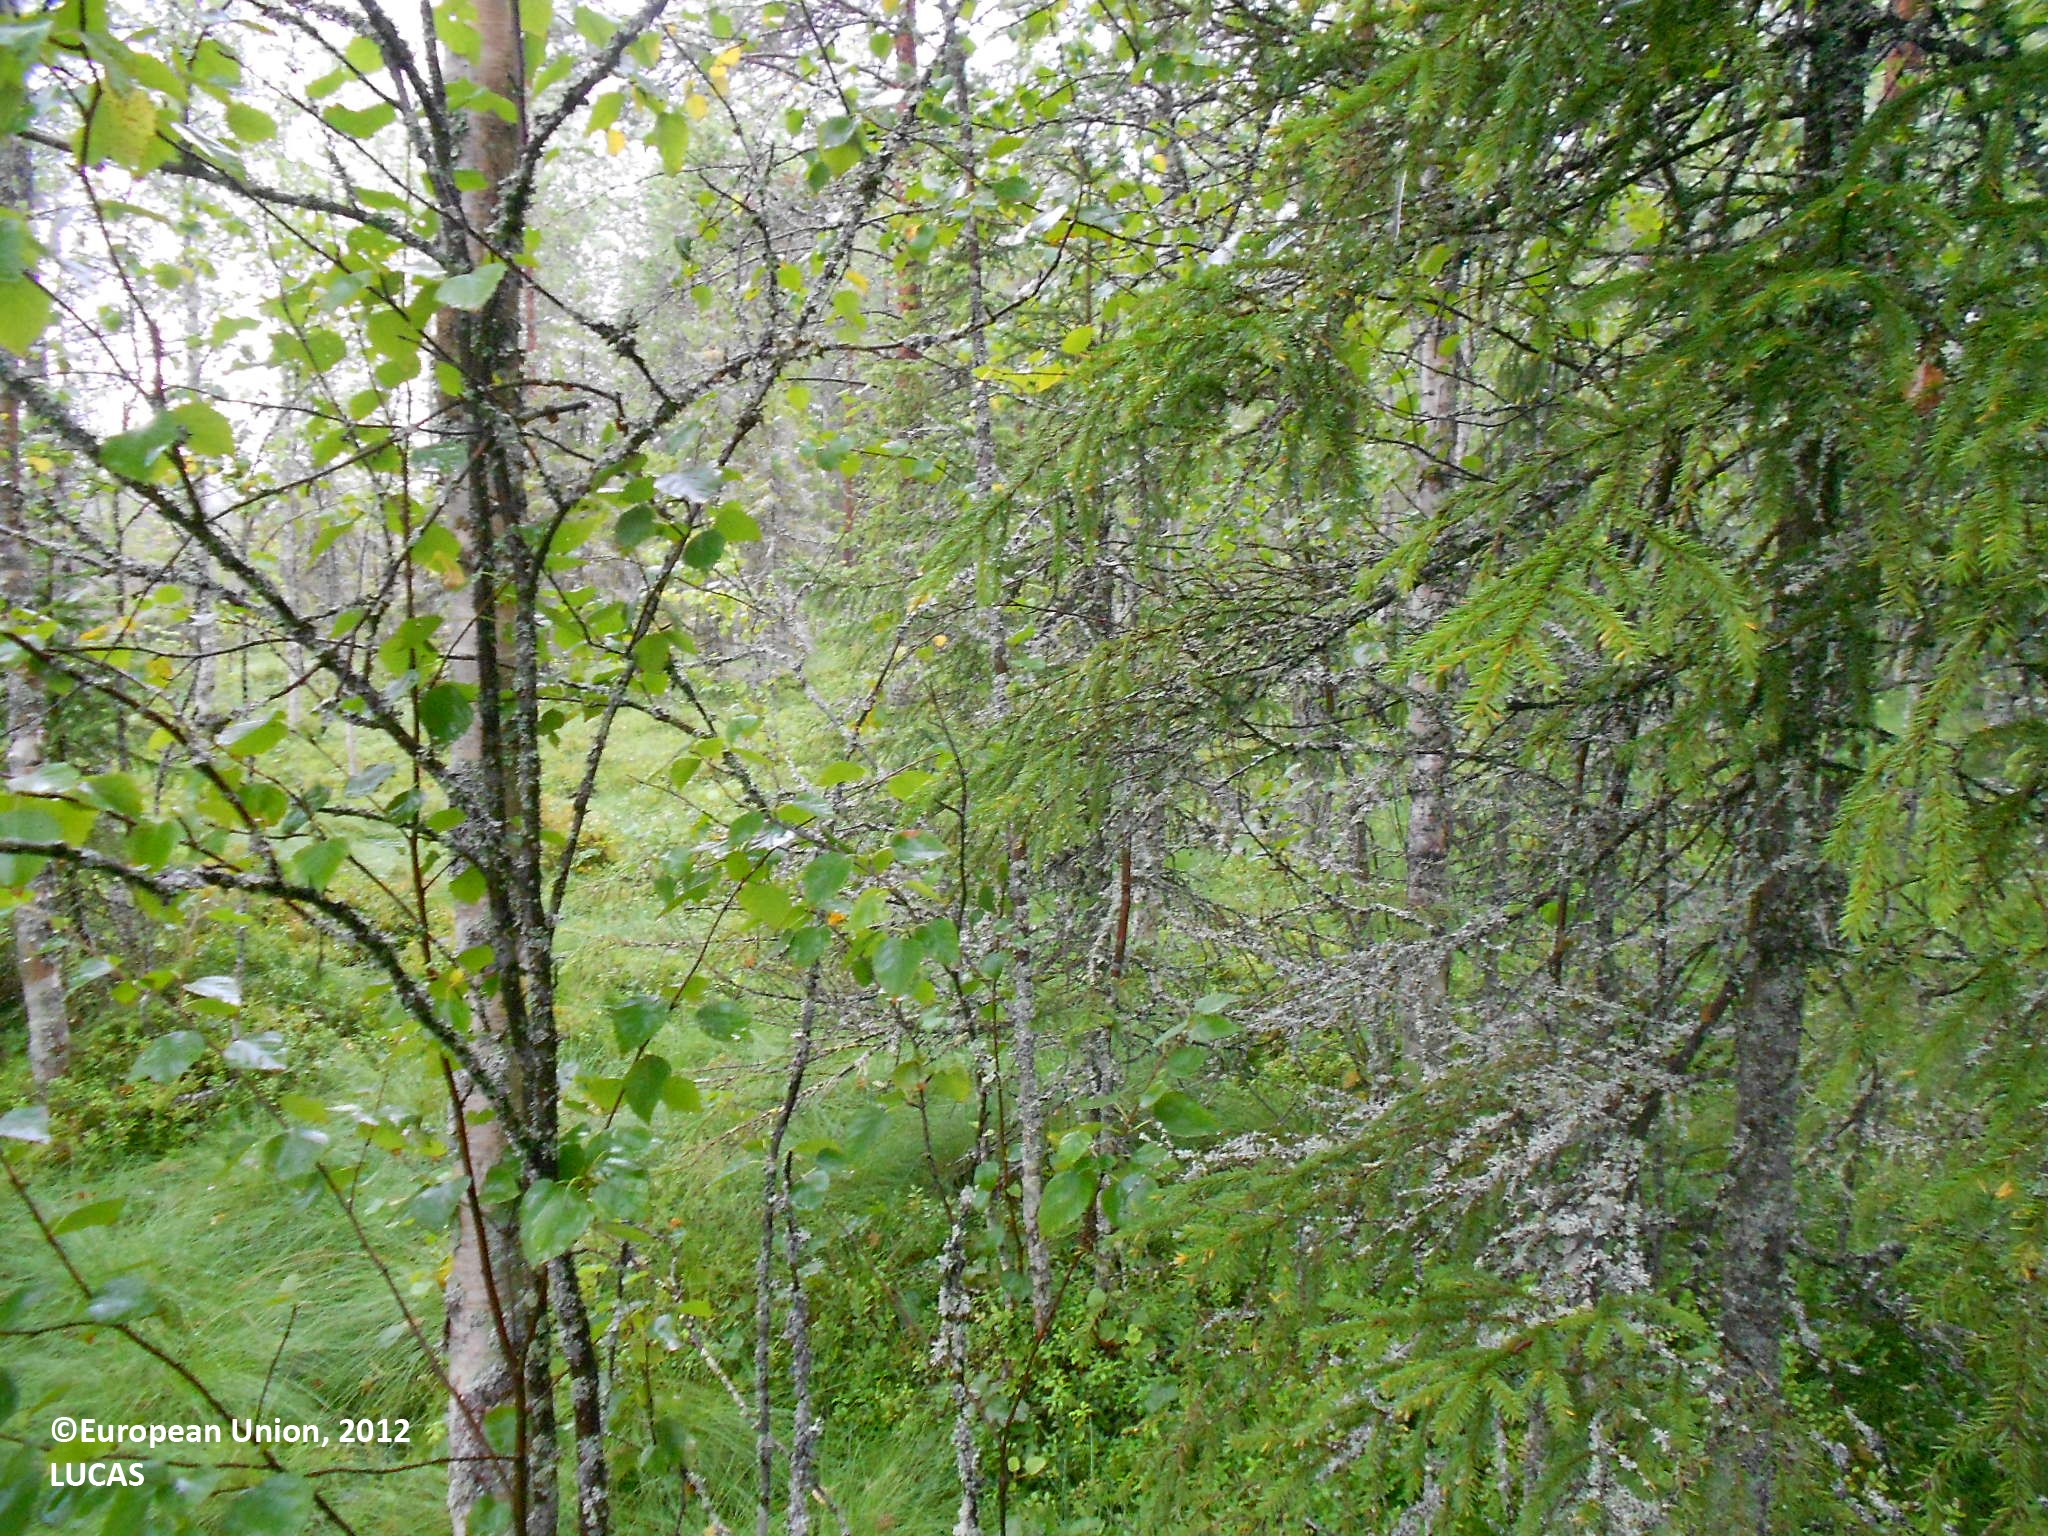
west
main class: Woodland
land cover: Pine dominated mixed woodland
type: boreal forest
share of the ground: 50 - 75 %
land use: Forestry
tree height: > 5 m
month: August
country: FI
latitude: 63.9250
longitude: 28.2203
